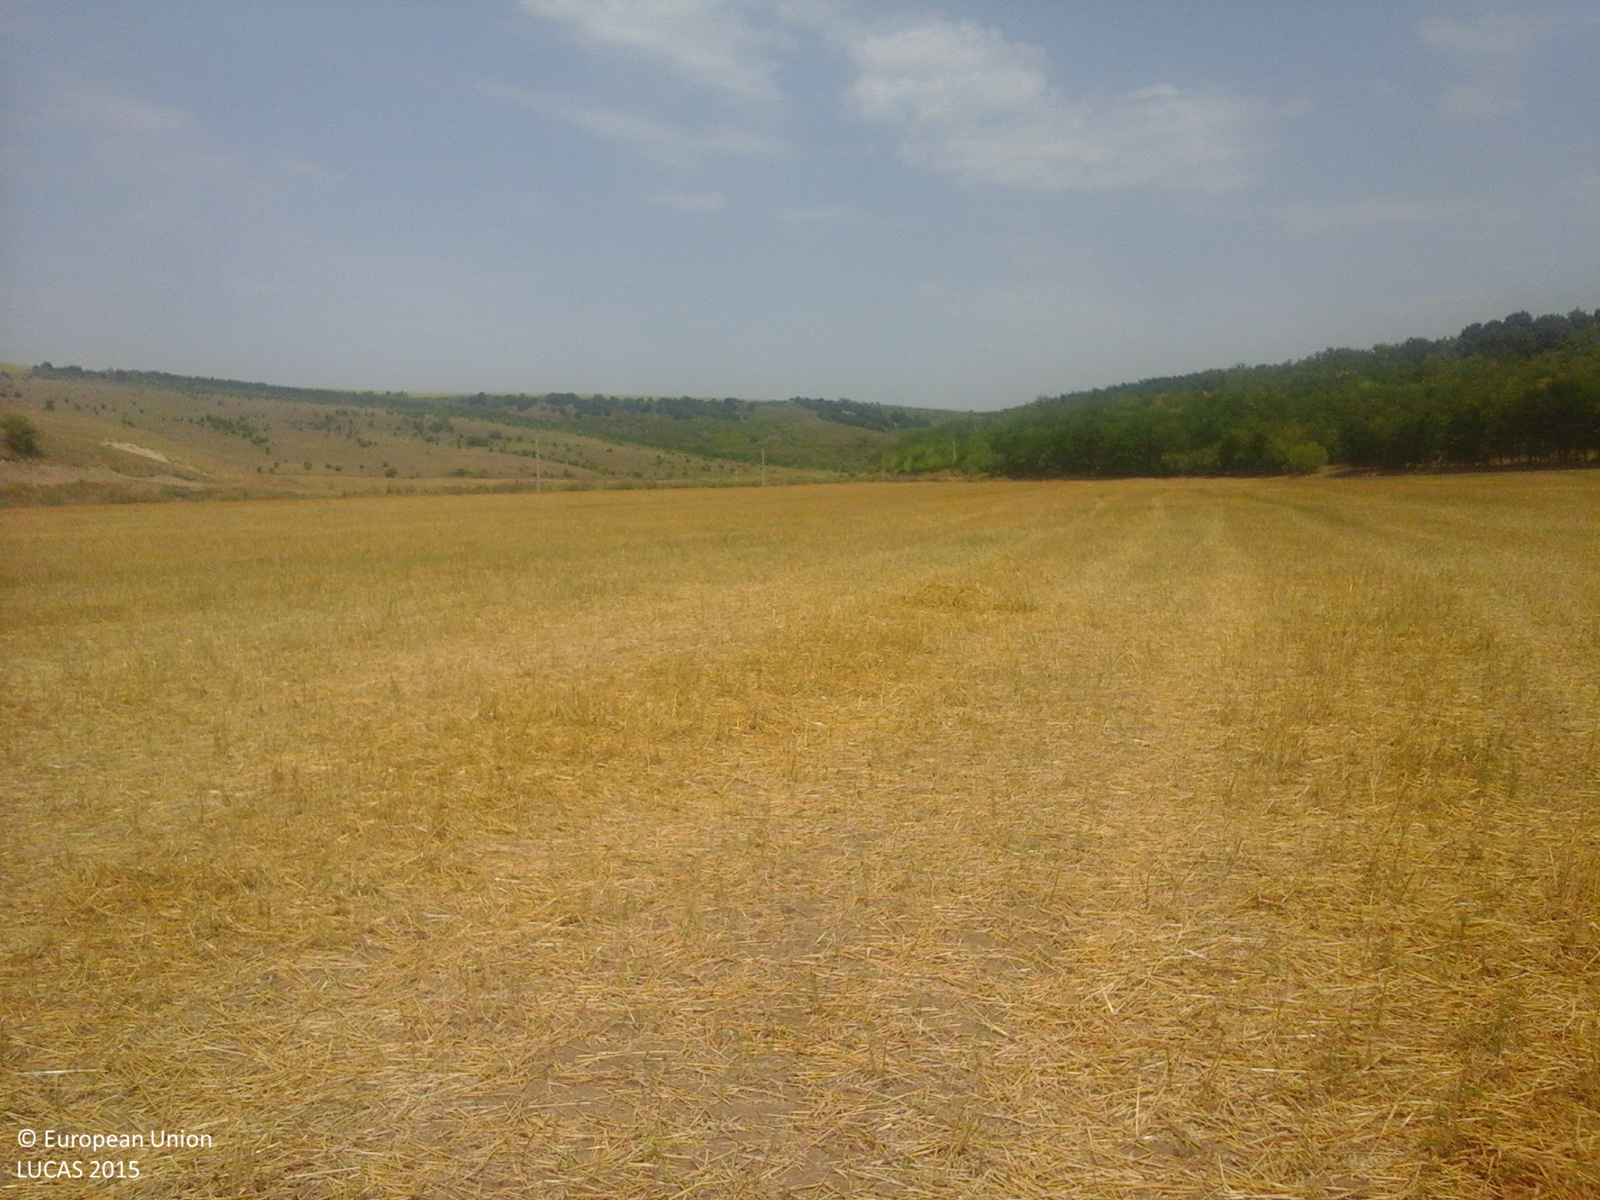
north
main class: Cropland
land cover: Common wheat
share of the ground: 25 - 50 %
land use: Agriculture (excluding fallow land and kitchen gardens)
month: August
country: RO
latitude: 44.0312
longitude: 27.8019
